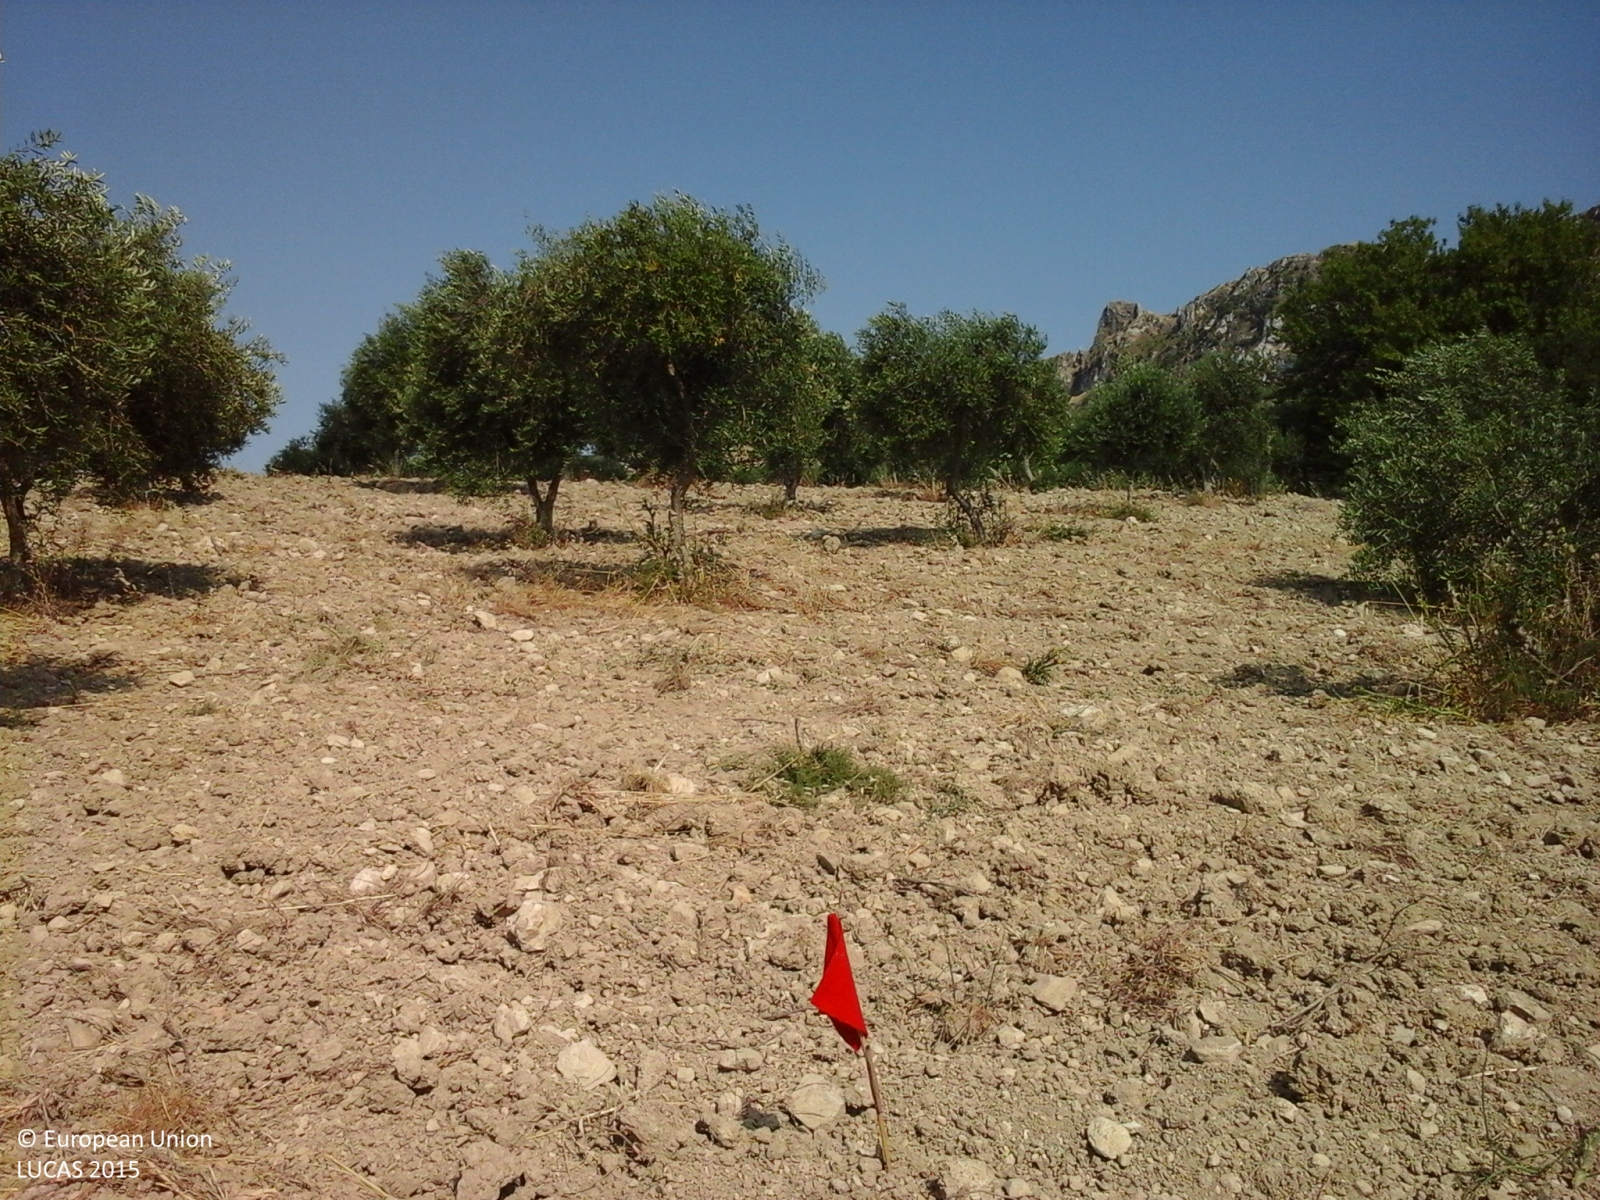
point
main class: Cropland
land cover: Olive groves
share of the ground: 25 - 50 %
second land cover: Other bare soil
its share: > 75 %
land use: Agriculture (excluding fallow land and kitchen gardens)
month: July
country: IT
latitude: 37.5854
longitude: 13.1807
